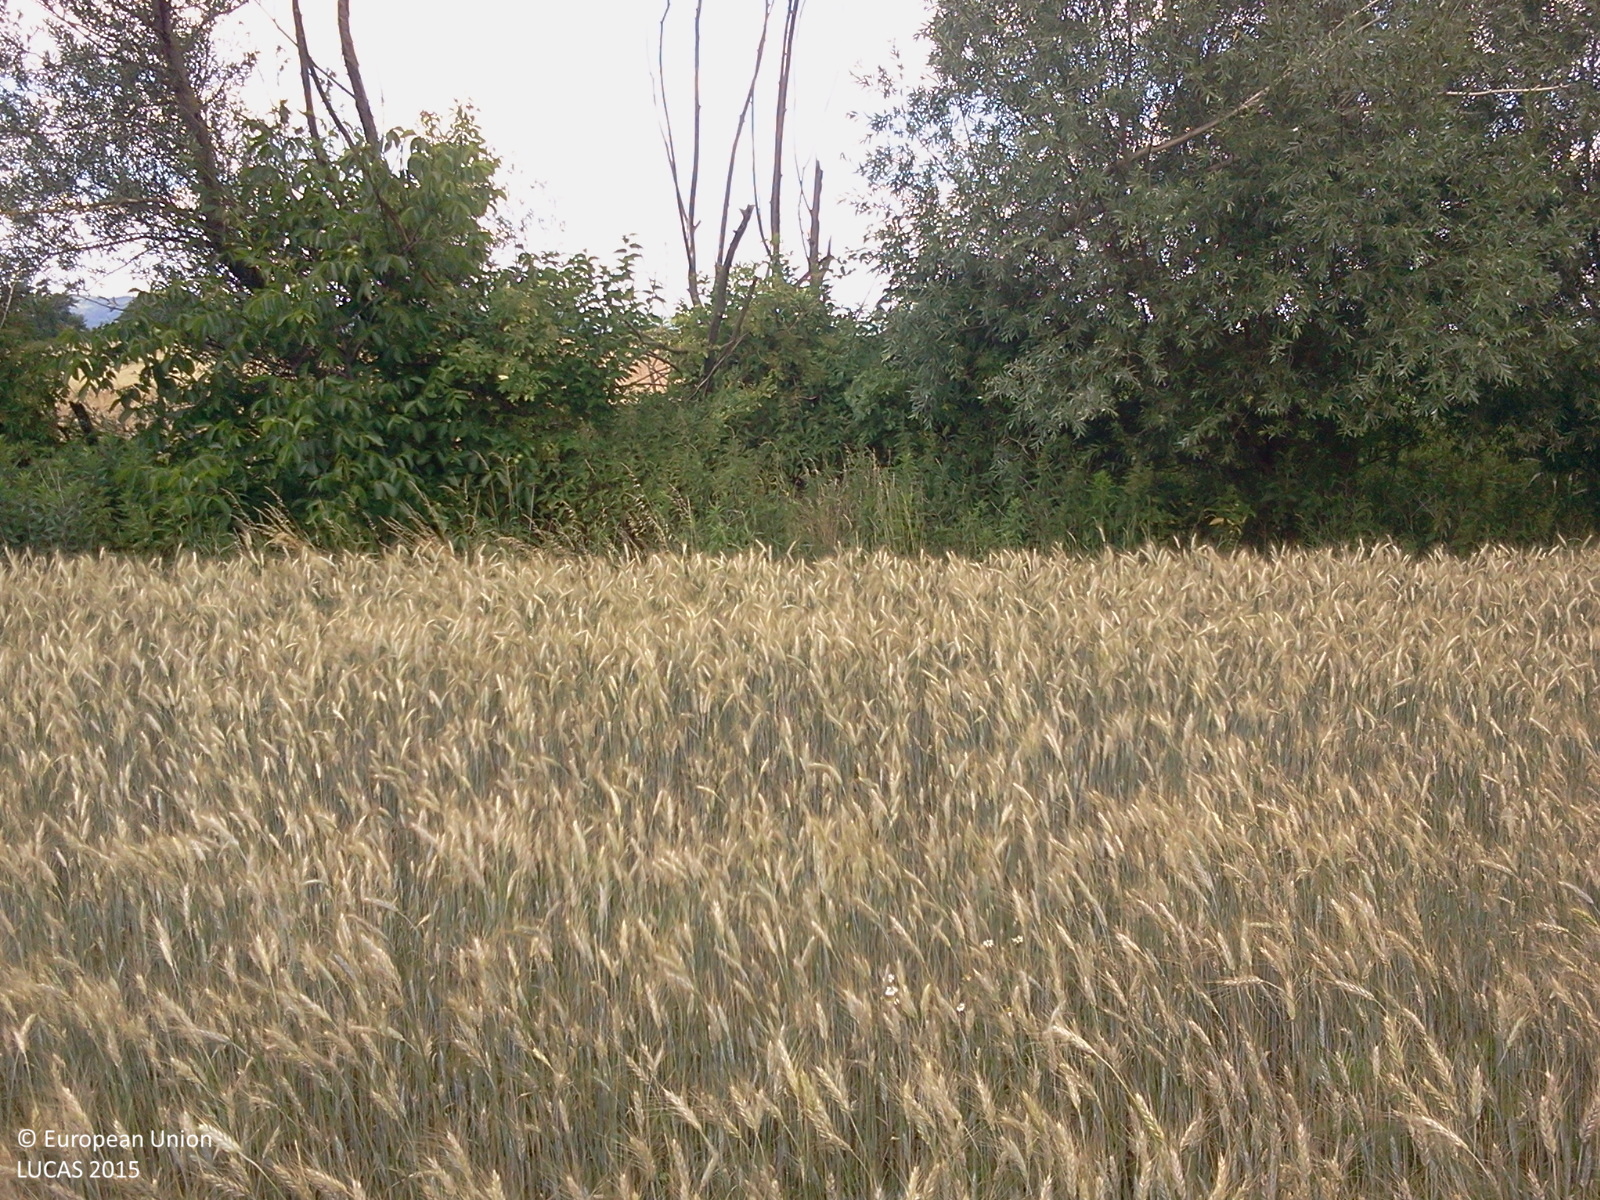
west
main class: Cropland
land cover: Durum wheat
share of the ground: > 75 %
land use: Agriculture (excluding fallow land and kitchen gardens)
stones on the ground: < 10 %
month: June
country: HU
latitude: 46.9637
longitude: 17.1147
